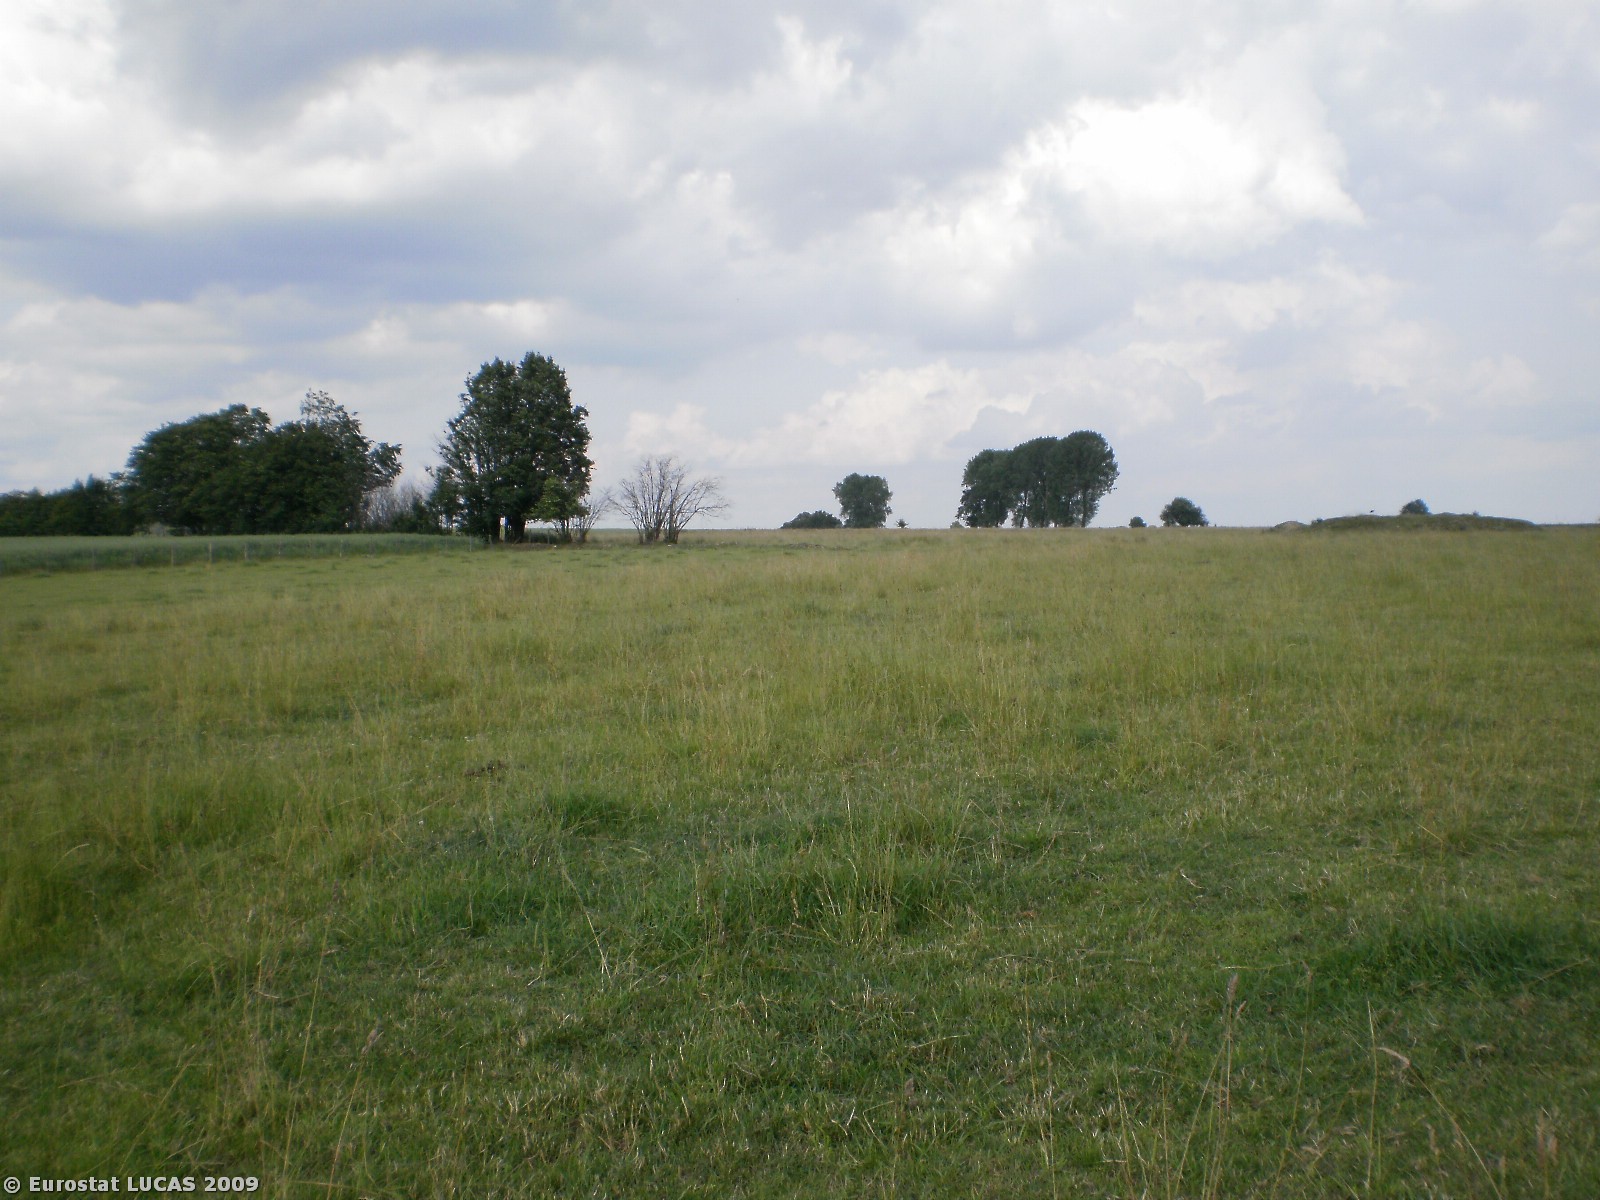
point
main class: Grassland
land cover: Grassland without tree/shrub cover
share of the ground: > 75 %
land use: Agriculture (excluding fallow land and kitchen gardens)
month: July
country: PL
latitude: 53.2893
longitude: 20.4932
